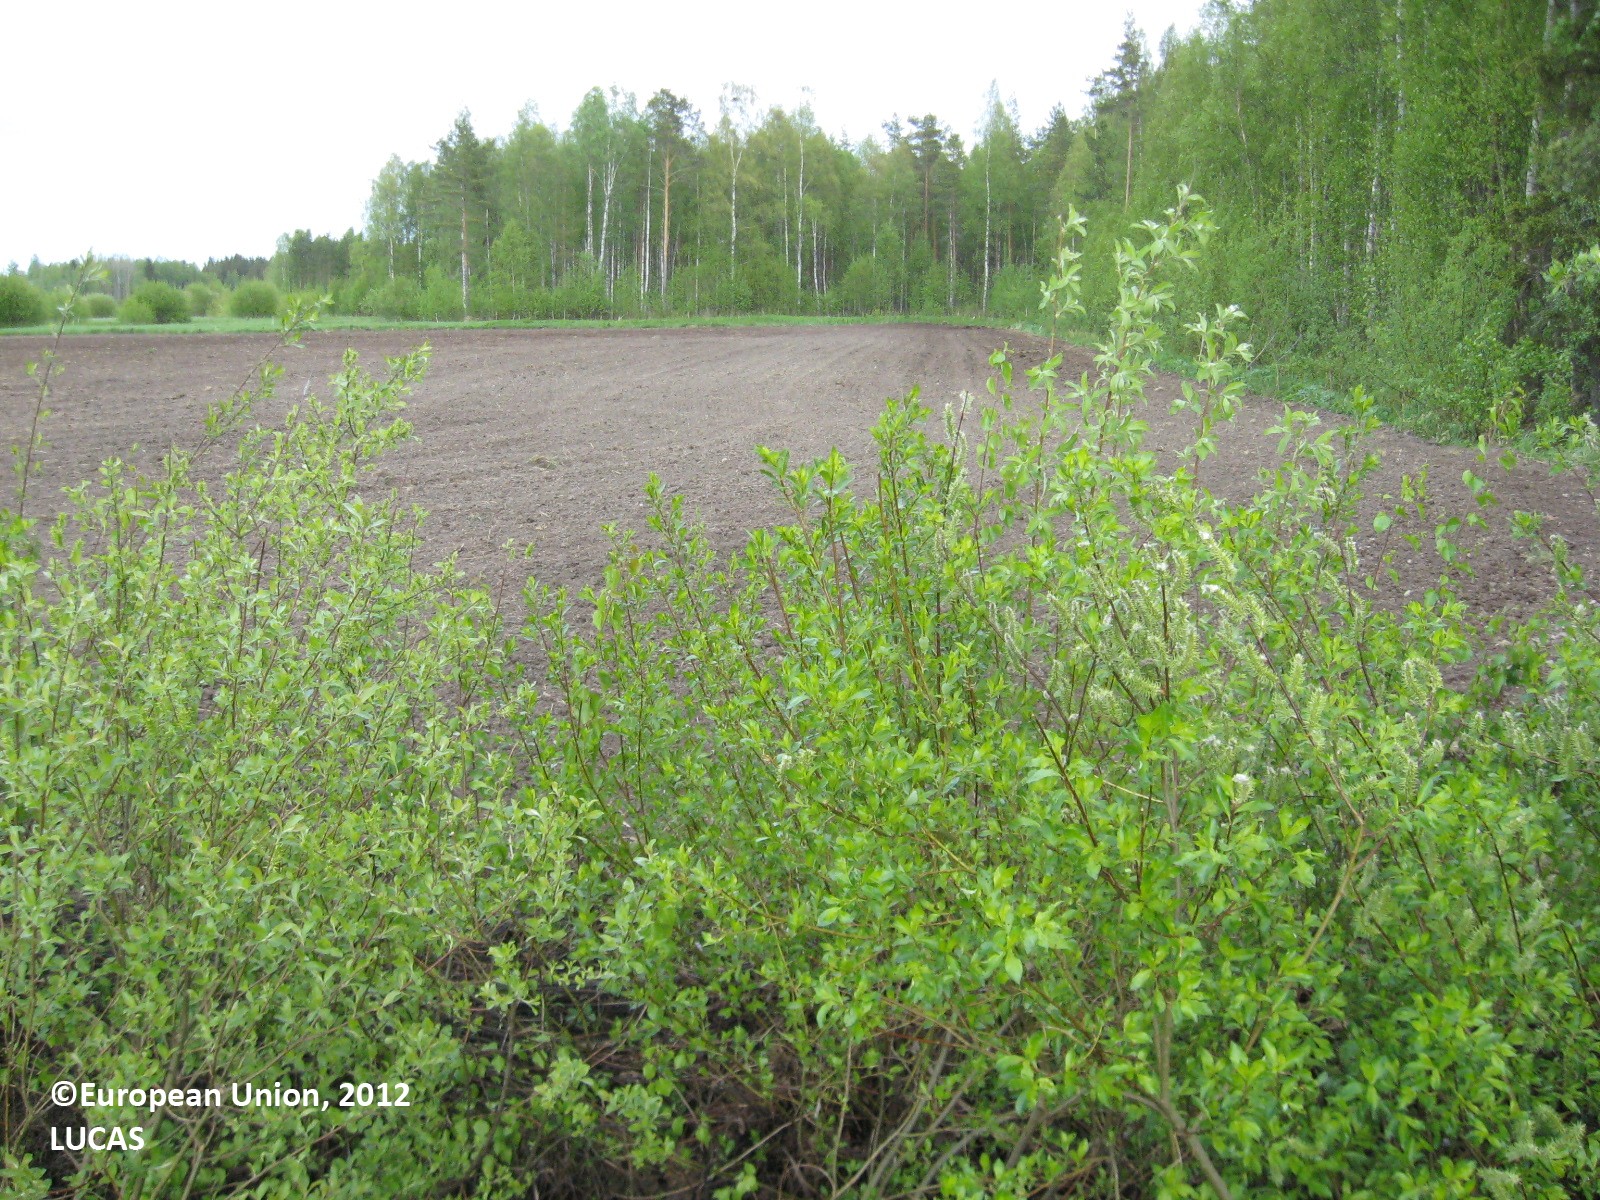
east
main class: Cropland
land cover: Oats
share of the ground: > 75 %
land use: Agriculture (excluding fallow land and kitchen gardens)
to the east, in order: Oats; Ditches and canals; Temporary grasslands; Ditches and canals; Temporary grasslands; Ditches and canals; Broadleaved woodland; Other mixed woodland; Ditches and canals; Other mixed woodland; Ditches and canals; Other mixed woodland
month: May
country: FI
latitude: 61.7913
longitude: 22.5596
